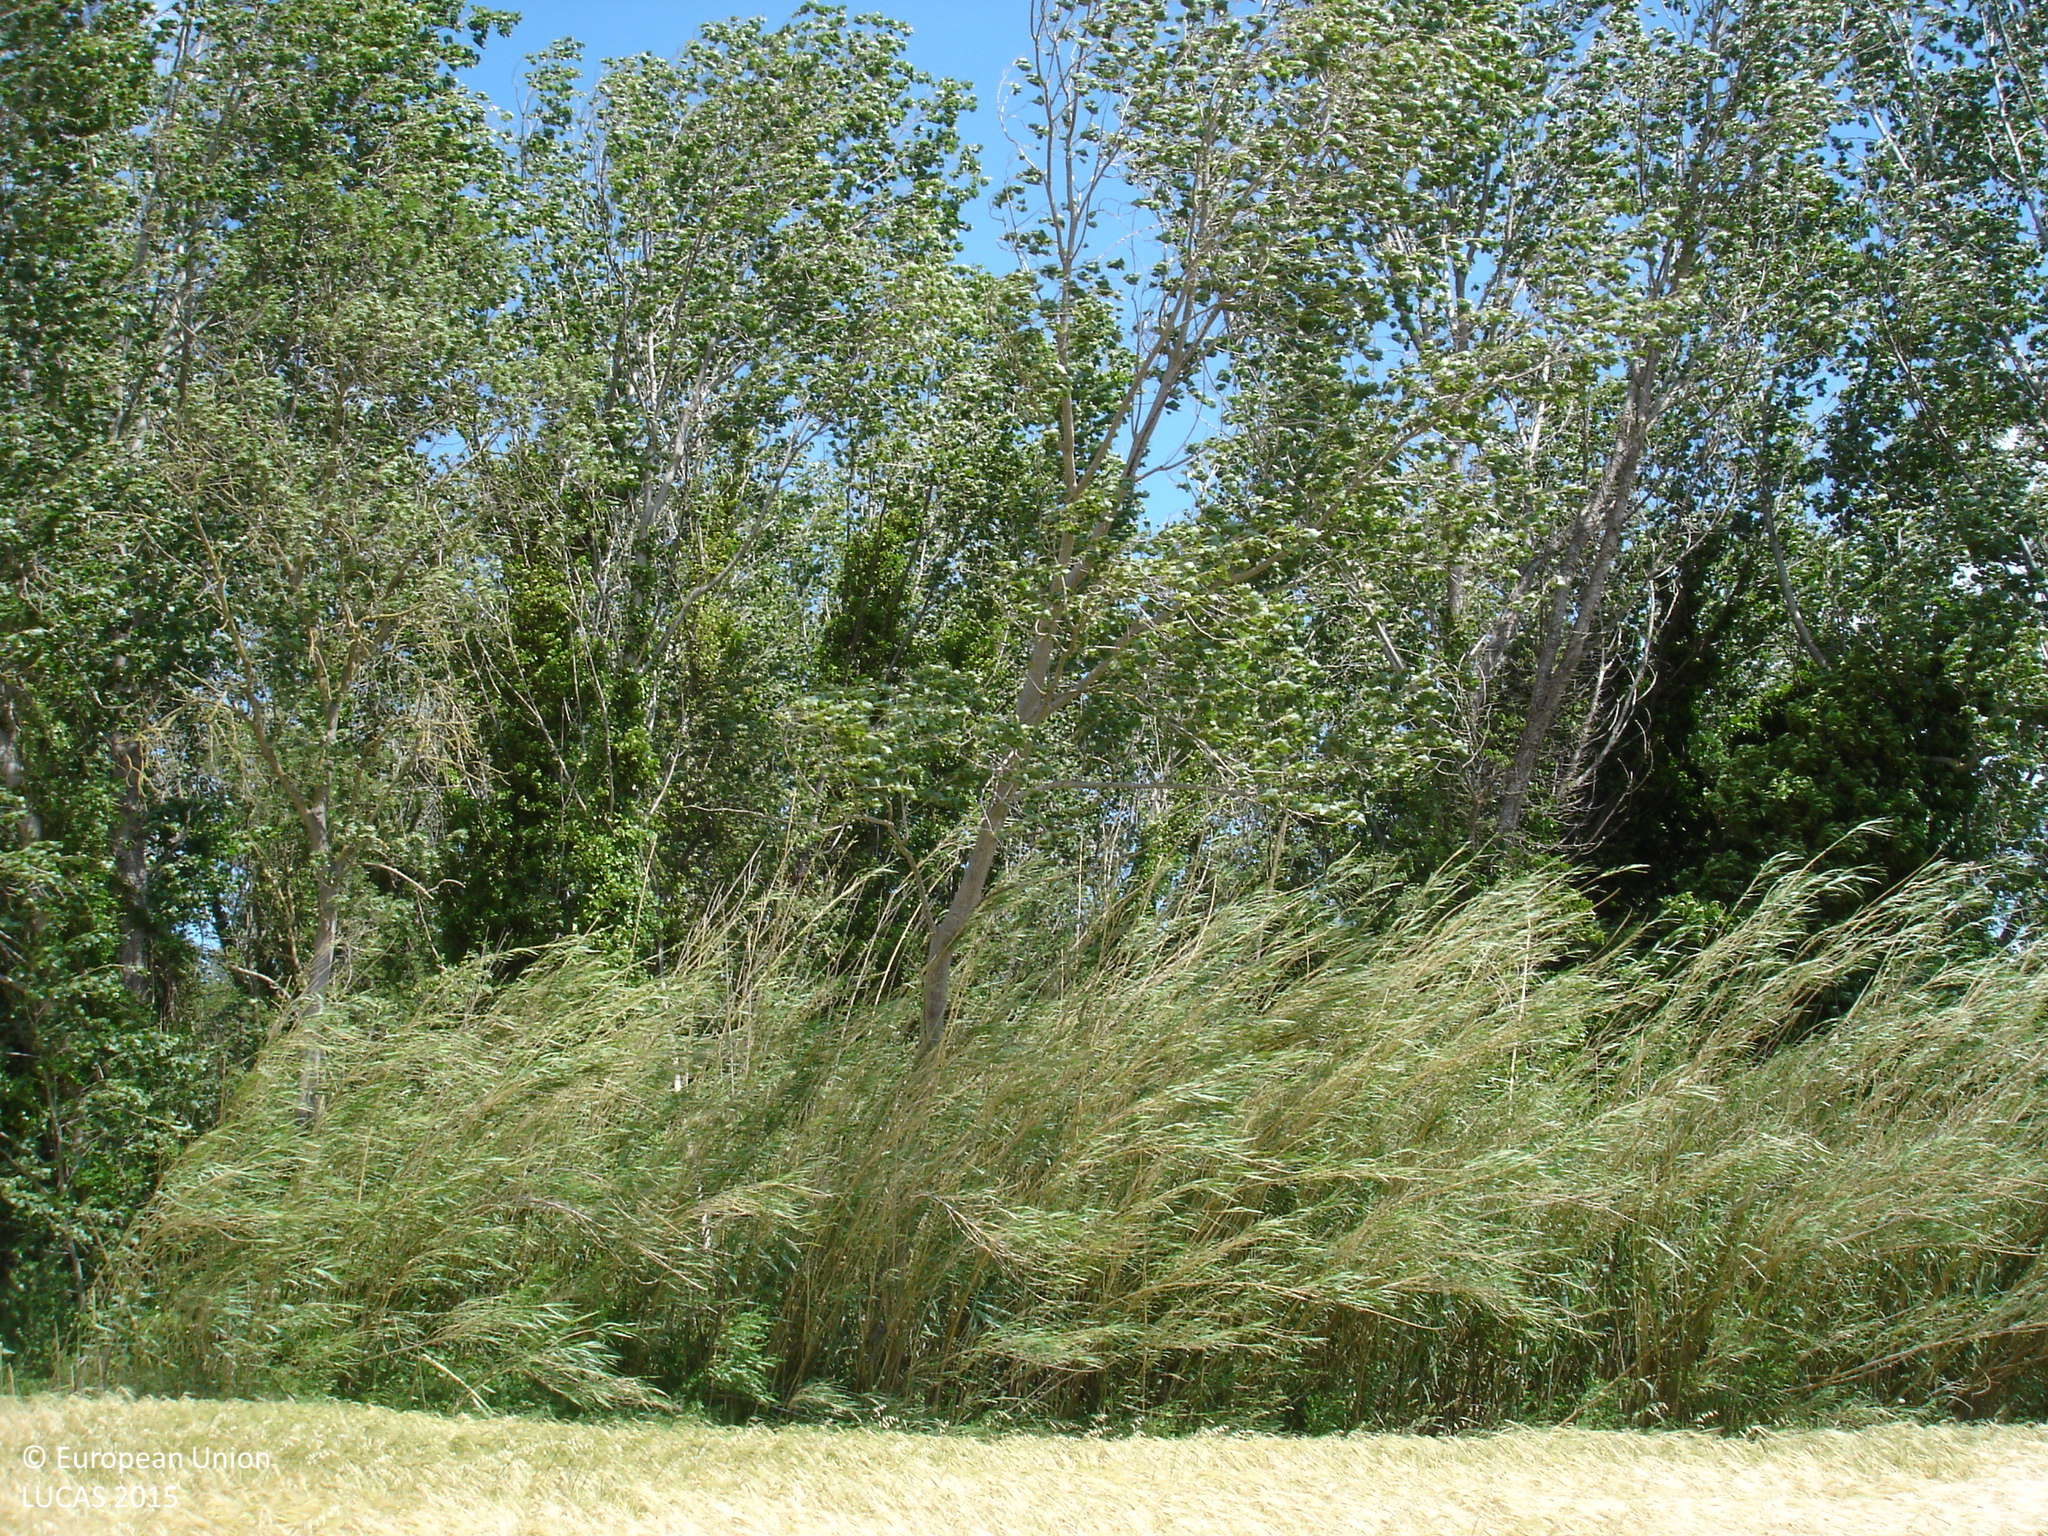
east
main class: Cropland
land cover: Barley
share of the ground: > 75 %
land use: Agriculture (excluding fallow land and kitchen gardens)
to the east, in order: Barley; Grass margins; Broadleaved woodland; Fences; Grassland with sparse tree/shrub cover; Fences; Broadleaved woodland; Shrubland with sparse tree cover; Grassland with sparse tree/shrub cover; Fences; Grass margins; Tracks; Grass margins; Grassland with sparse tree/shrub cover
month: May
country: ES
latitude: 42.1814
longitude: 3.0773
